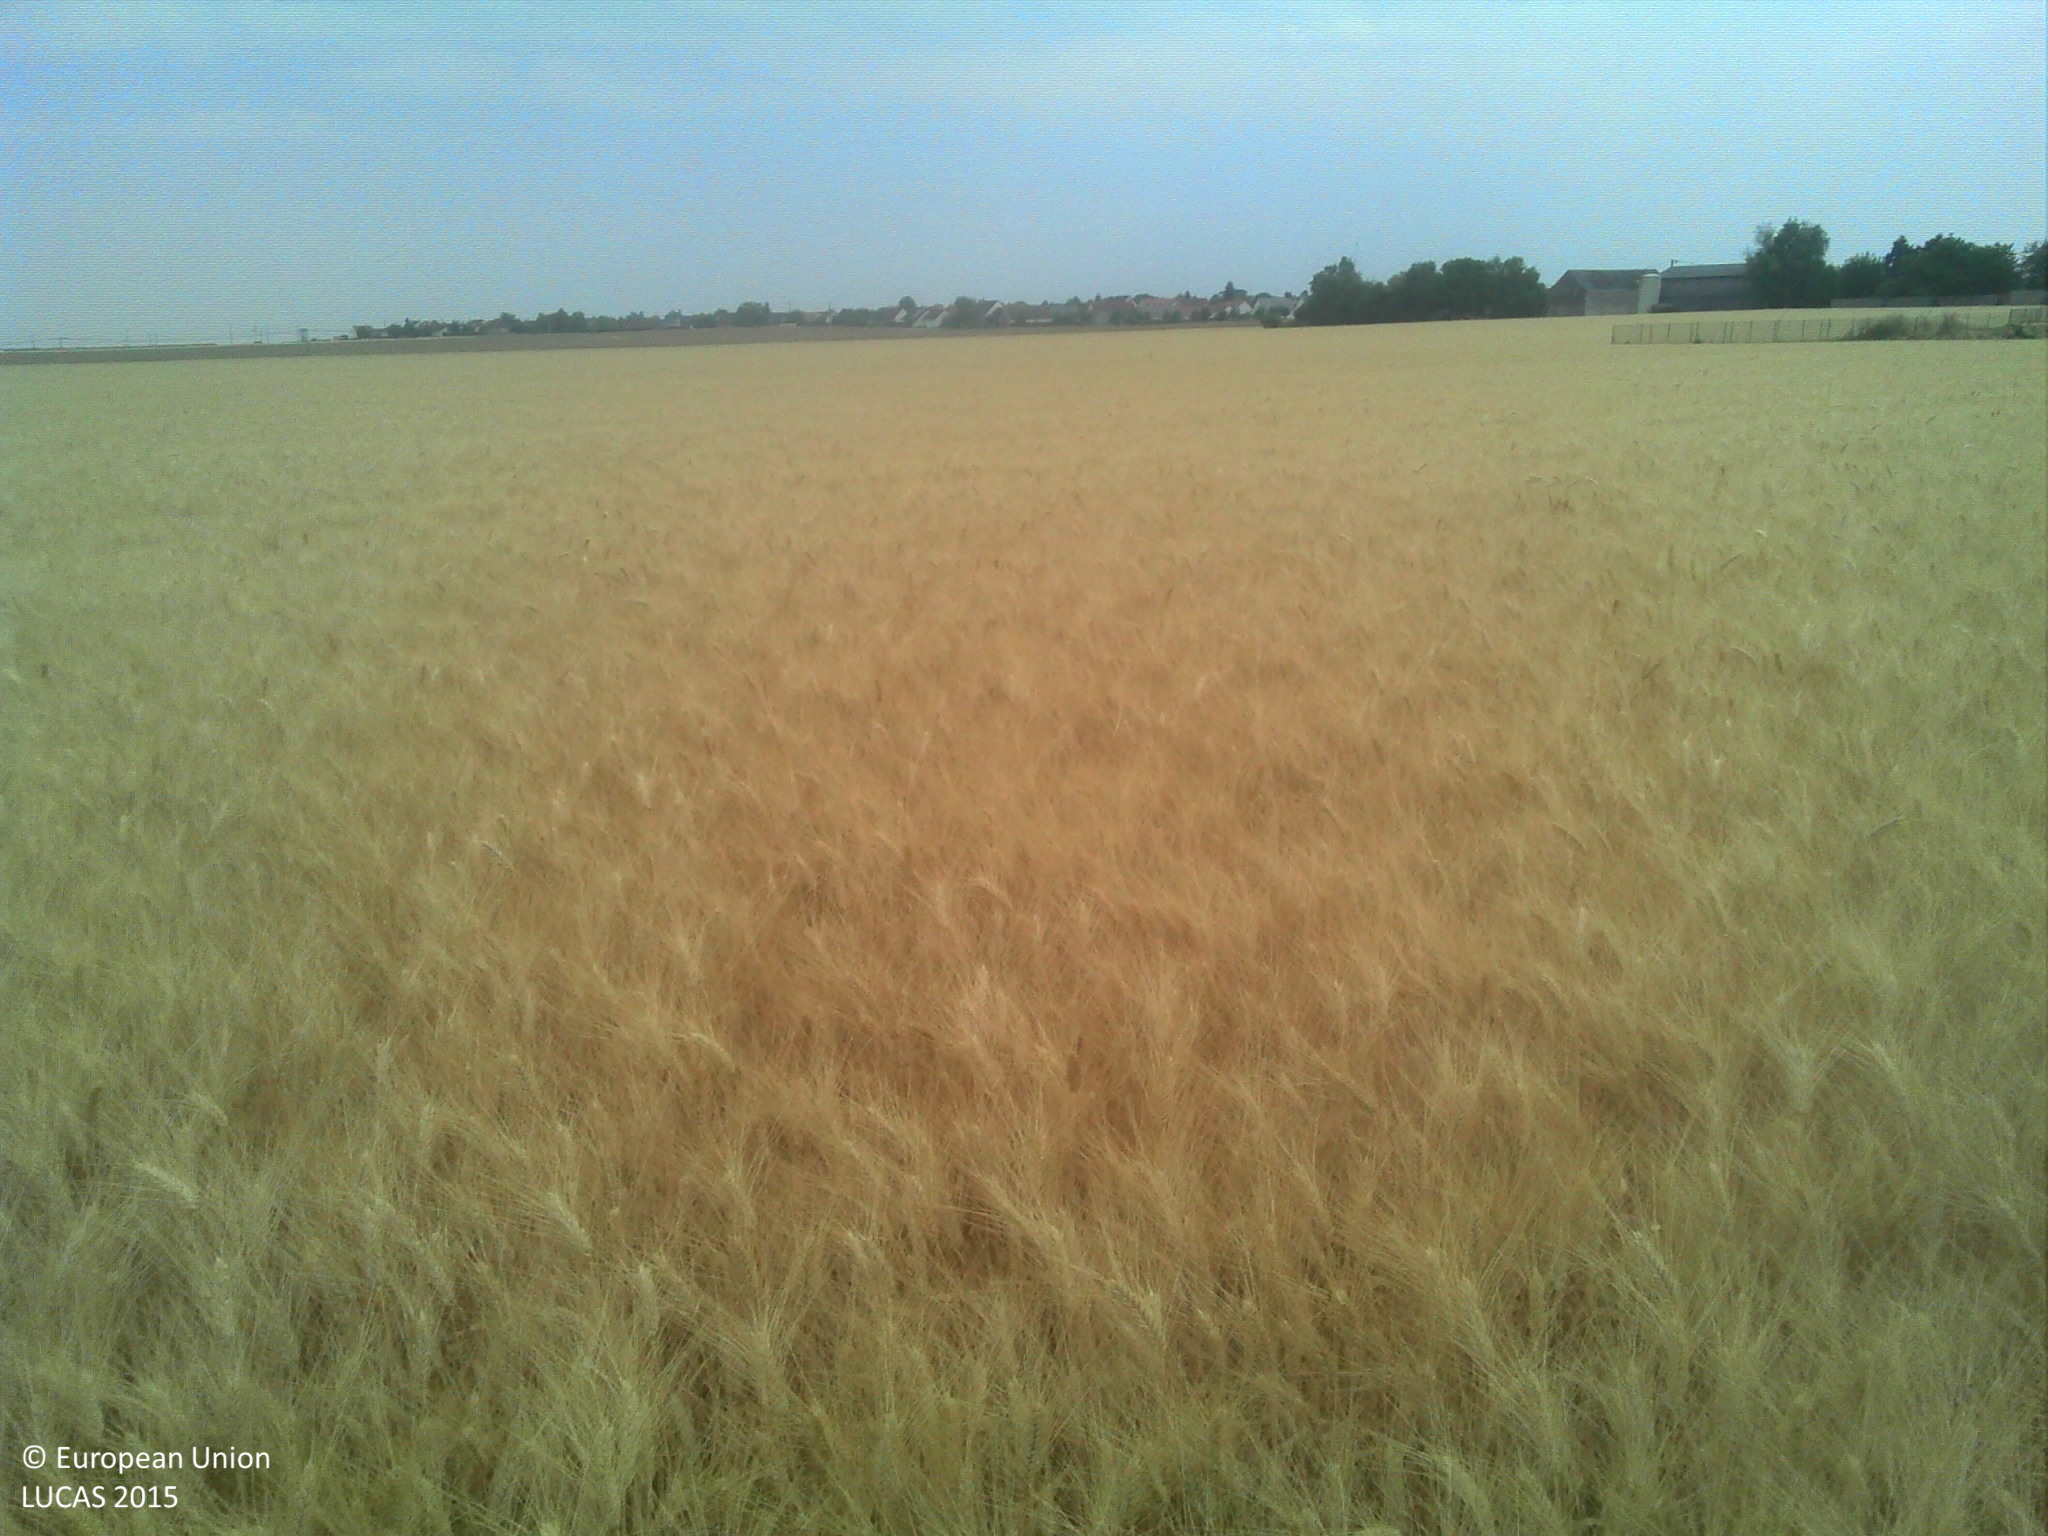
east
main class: Cropland
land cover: Durum wheat
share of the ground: > 75 %
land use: Agriculture (excluding fallow land and kitchen gardens)
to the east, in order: Durum wheat
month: July
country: FR
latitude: 47.6274
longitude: 1.3214
